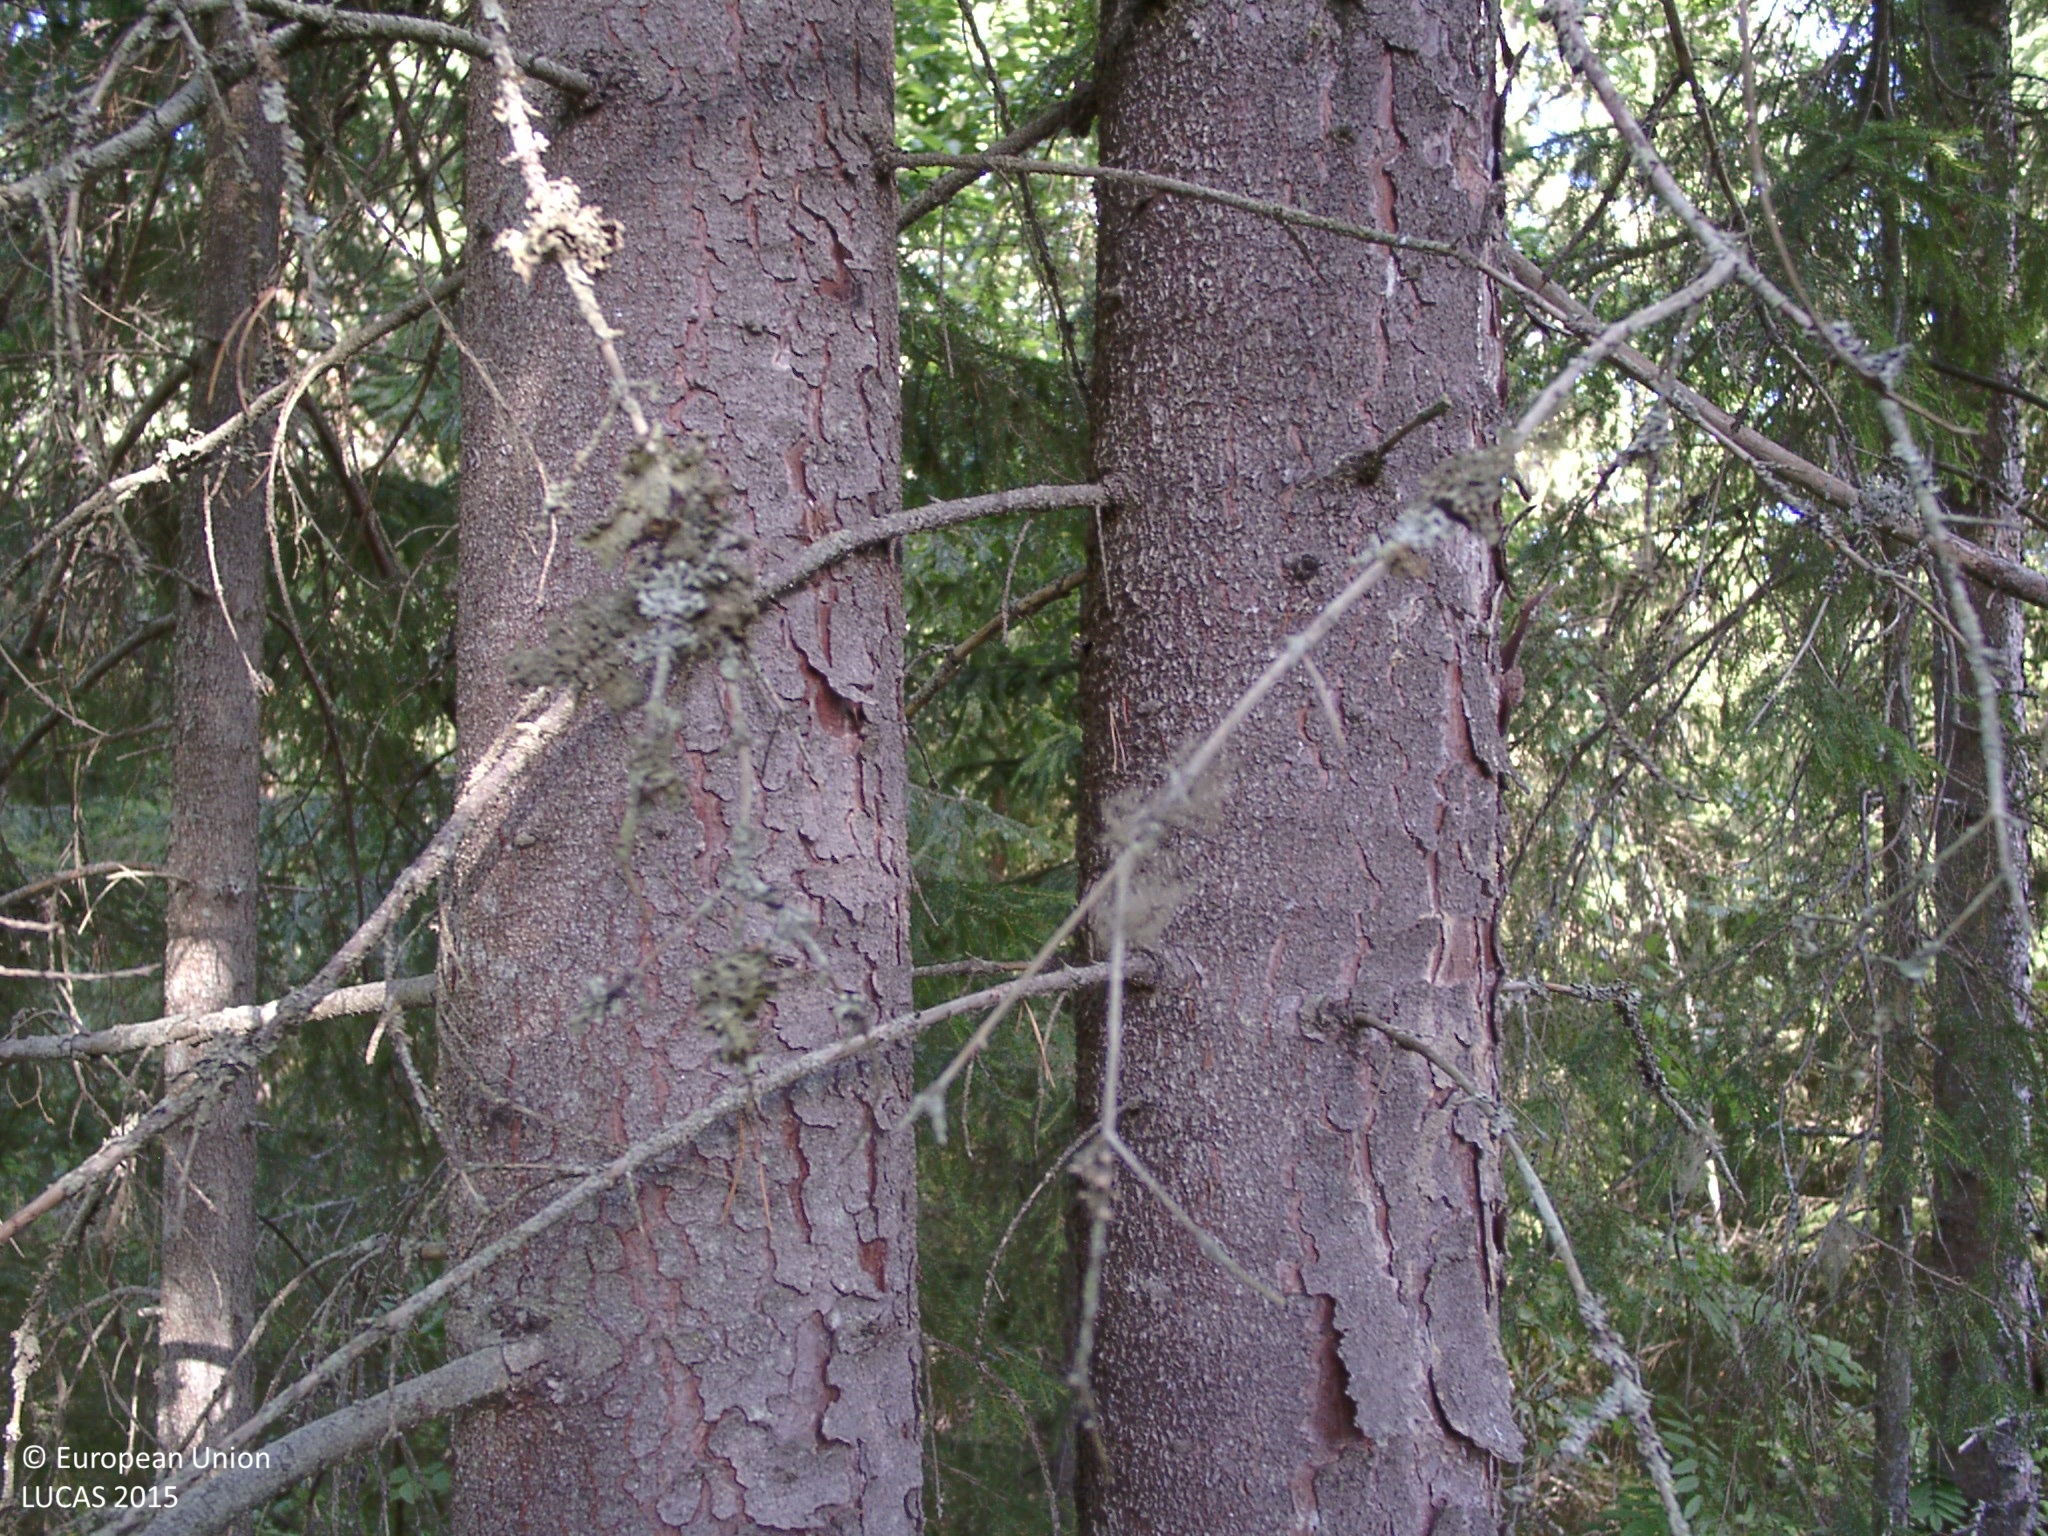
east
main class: Woodland
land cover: Spruce dominated mixed woodland
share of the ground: > 75 %
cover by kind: coniferous forest trees 40 %, broadleaved forest trees 35 %, shrubs 15 %, herbaceous plants 5 %, lichens and mosses 5 %
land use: Forestry
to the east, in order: Spruce dominated mixed woodland; Rivers and streams; Other mixed woodland; Spruce dominated mixed woodland; Artificial constructions in urban areas; Other mixed woodland; Spruce dominated mixed woodland; Tracks; Other mixed woodland; Pine dominated coniferous woodland; Peatbogs
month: August
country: FI
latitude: 62.3872
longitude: 25.7254
